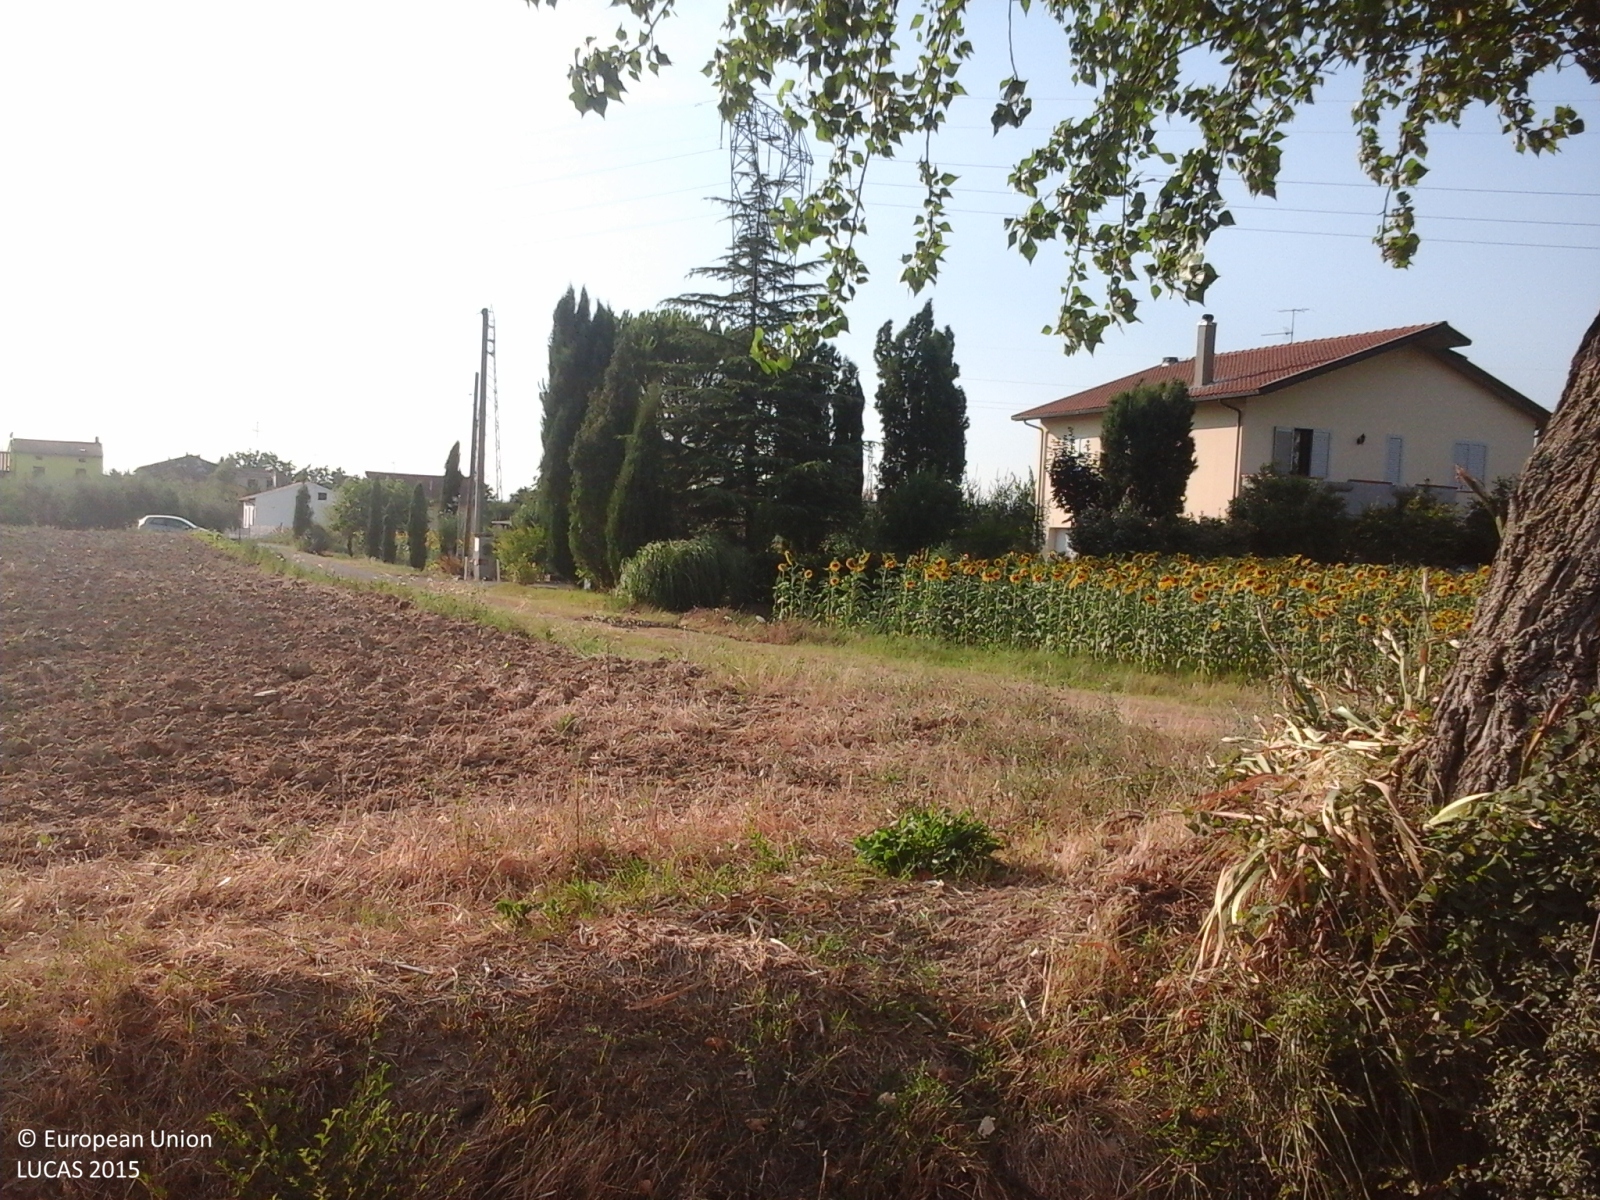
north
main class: Cropland
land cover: Maize
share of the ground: > 75 %
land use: Agriculture (excluding fallow land and kitchen gardens)
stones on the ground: < 10 %
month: July
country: IT
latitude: 43.7145
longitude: 10.9779
